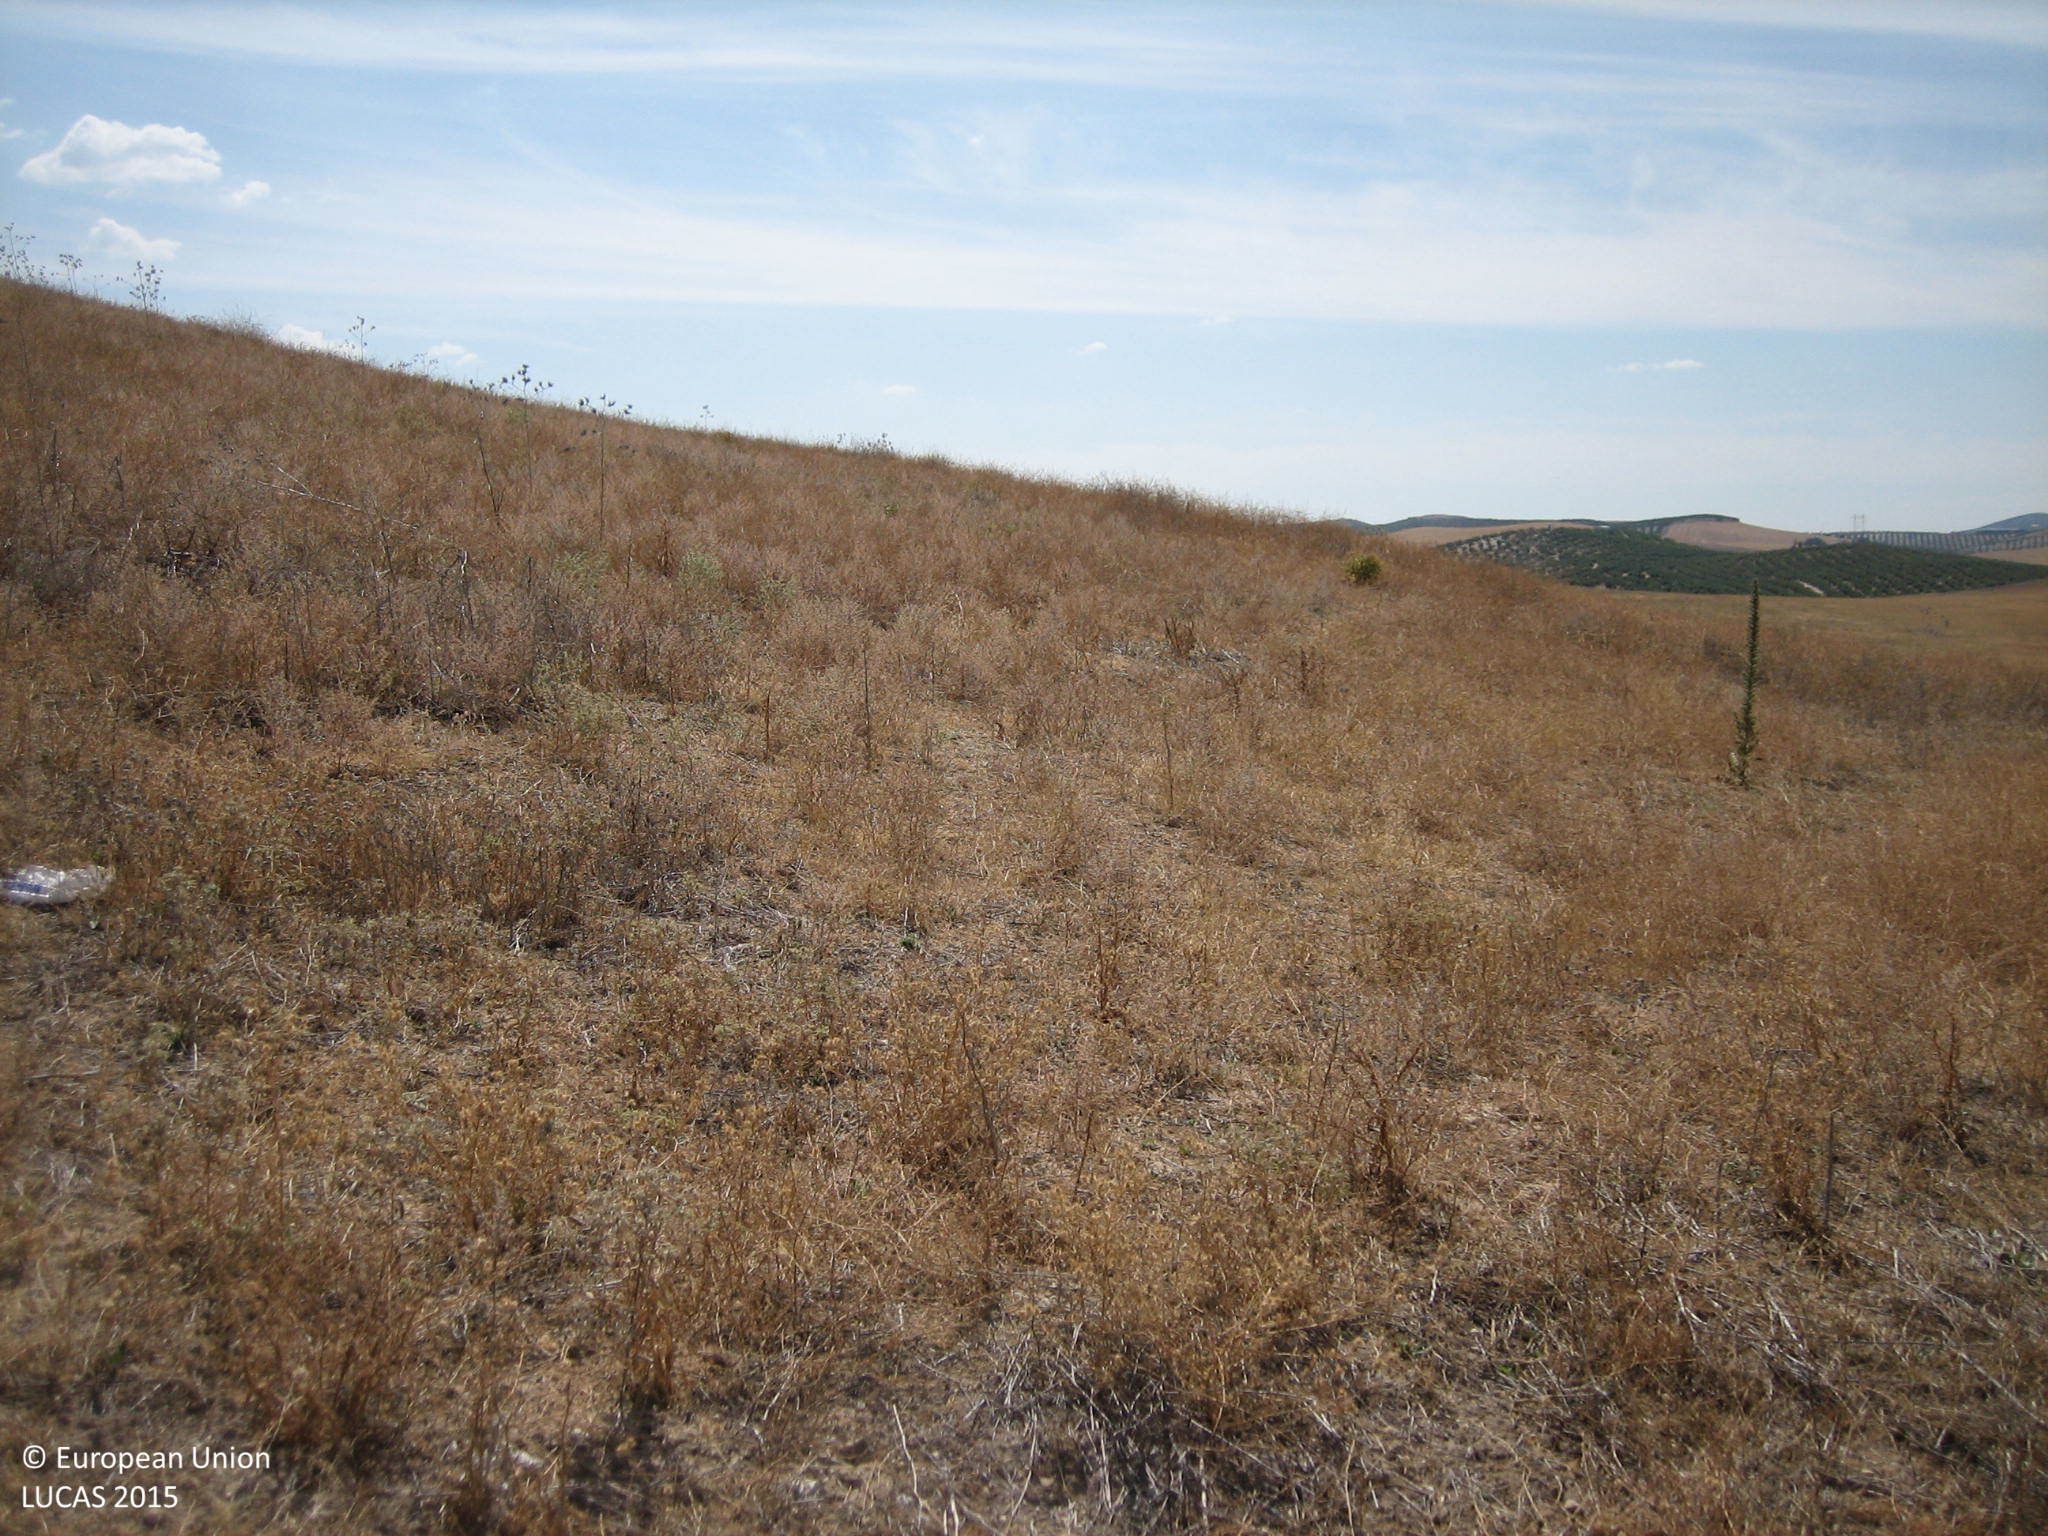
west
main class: Grassland
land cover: Grassland without tree/shrub cover
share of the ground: > 75 %
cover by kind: herbaceous plants 100 %
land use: Abandoned areas
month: June
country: ES
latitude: 37.8223
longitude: -3.7817
